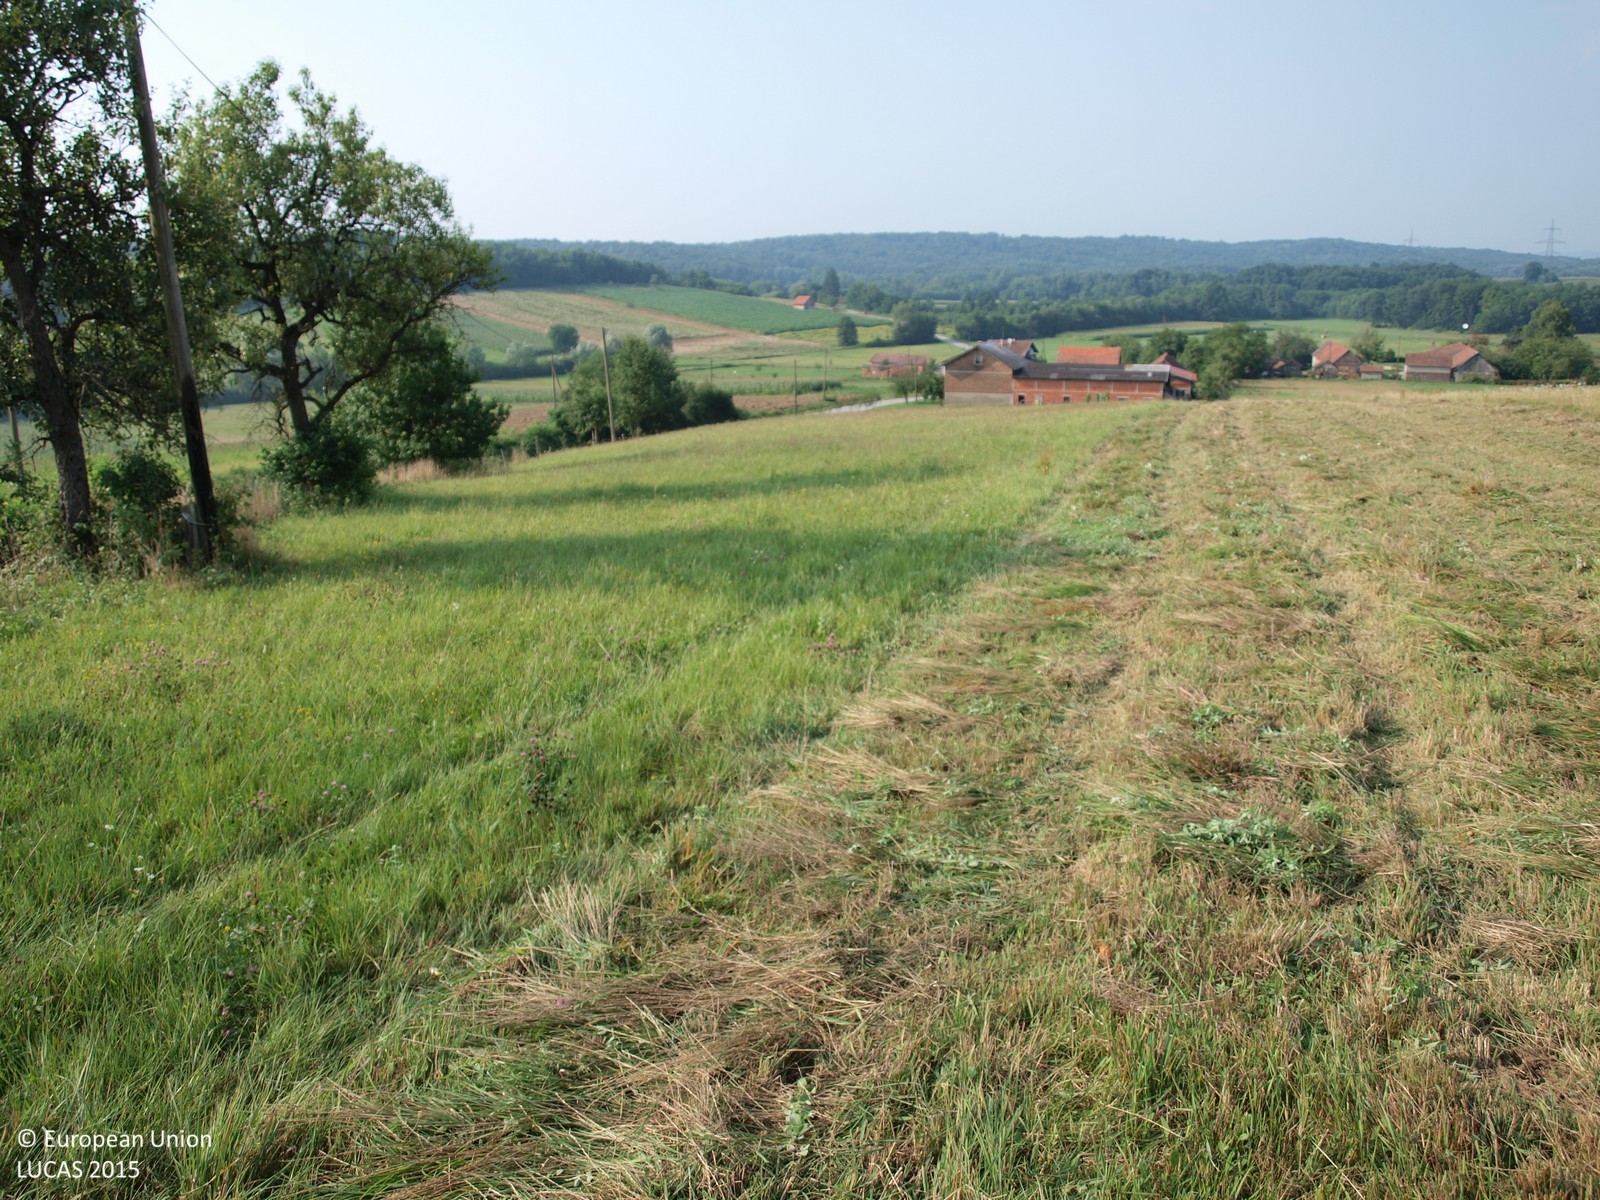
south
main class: Grassland
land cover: Grassland without tree/shrub cover
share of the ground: > 75 %
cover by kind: herbaceous plants 100 %
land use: Agriculture (excluding fallow land and kitchen gardens)
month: August
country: HR
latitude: 45.9436
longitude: 16.3844
